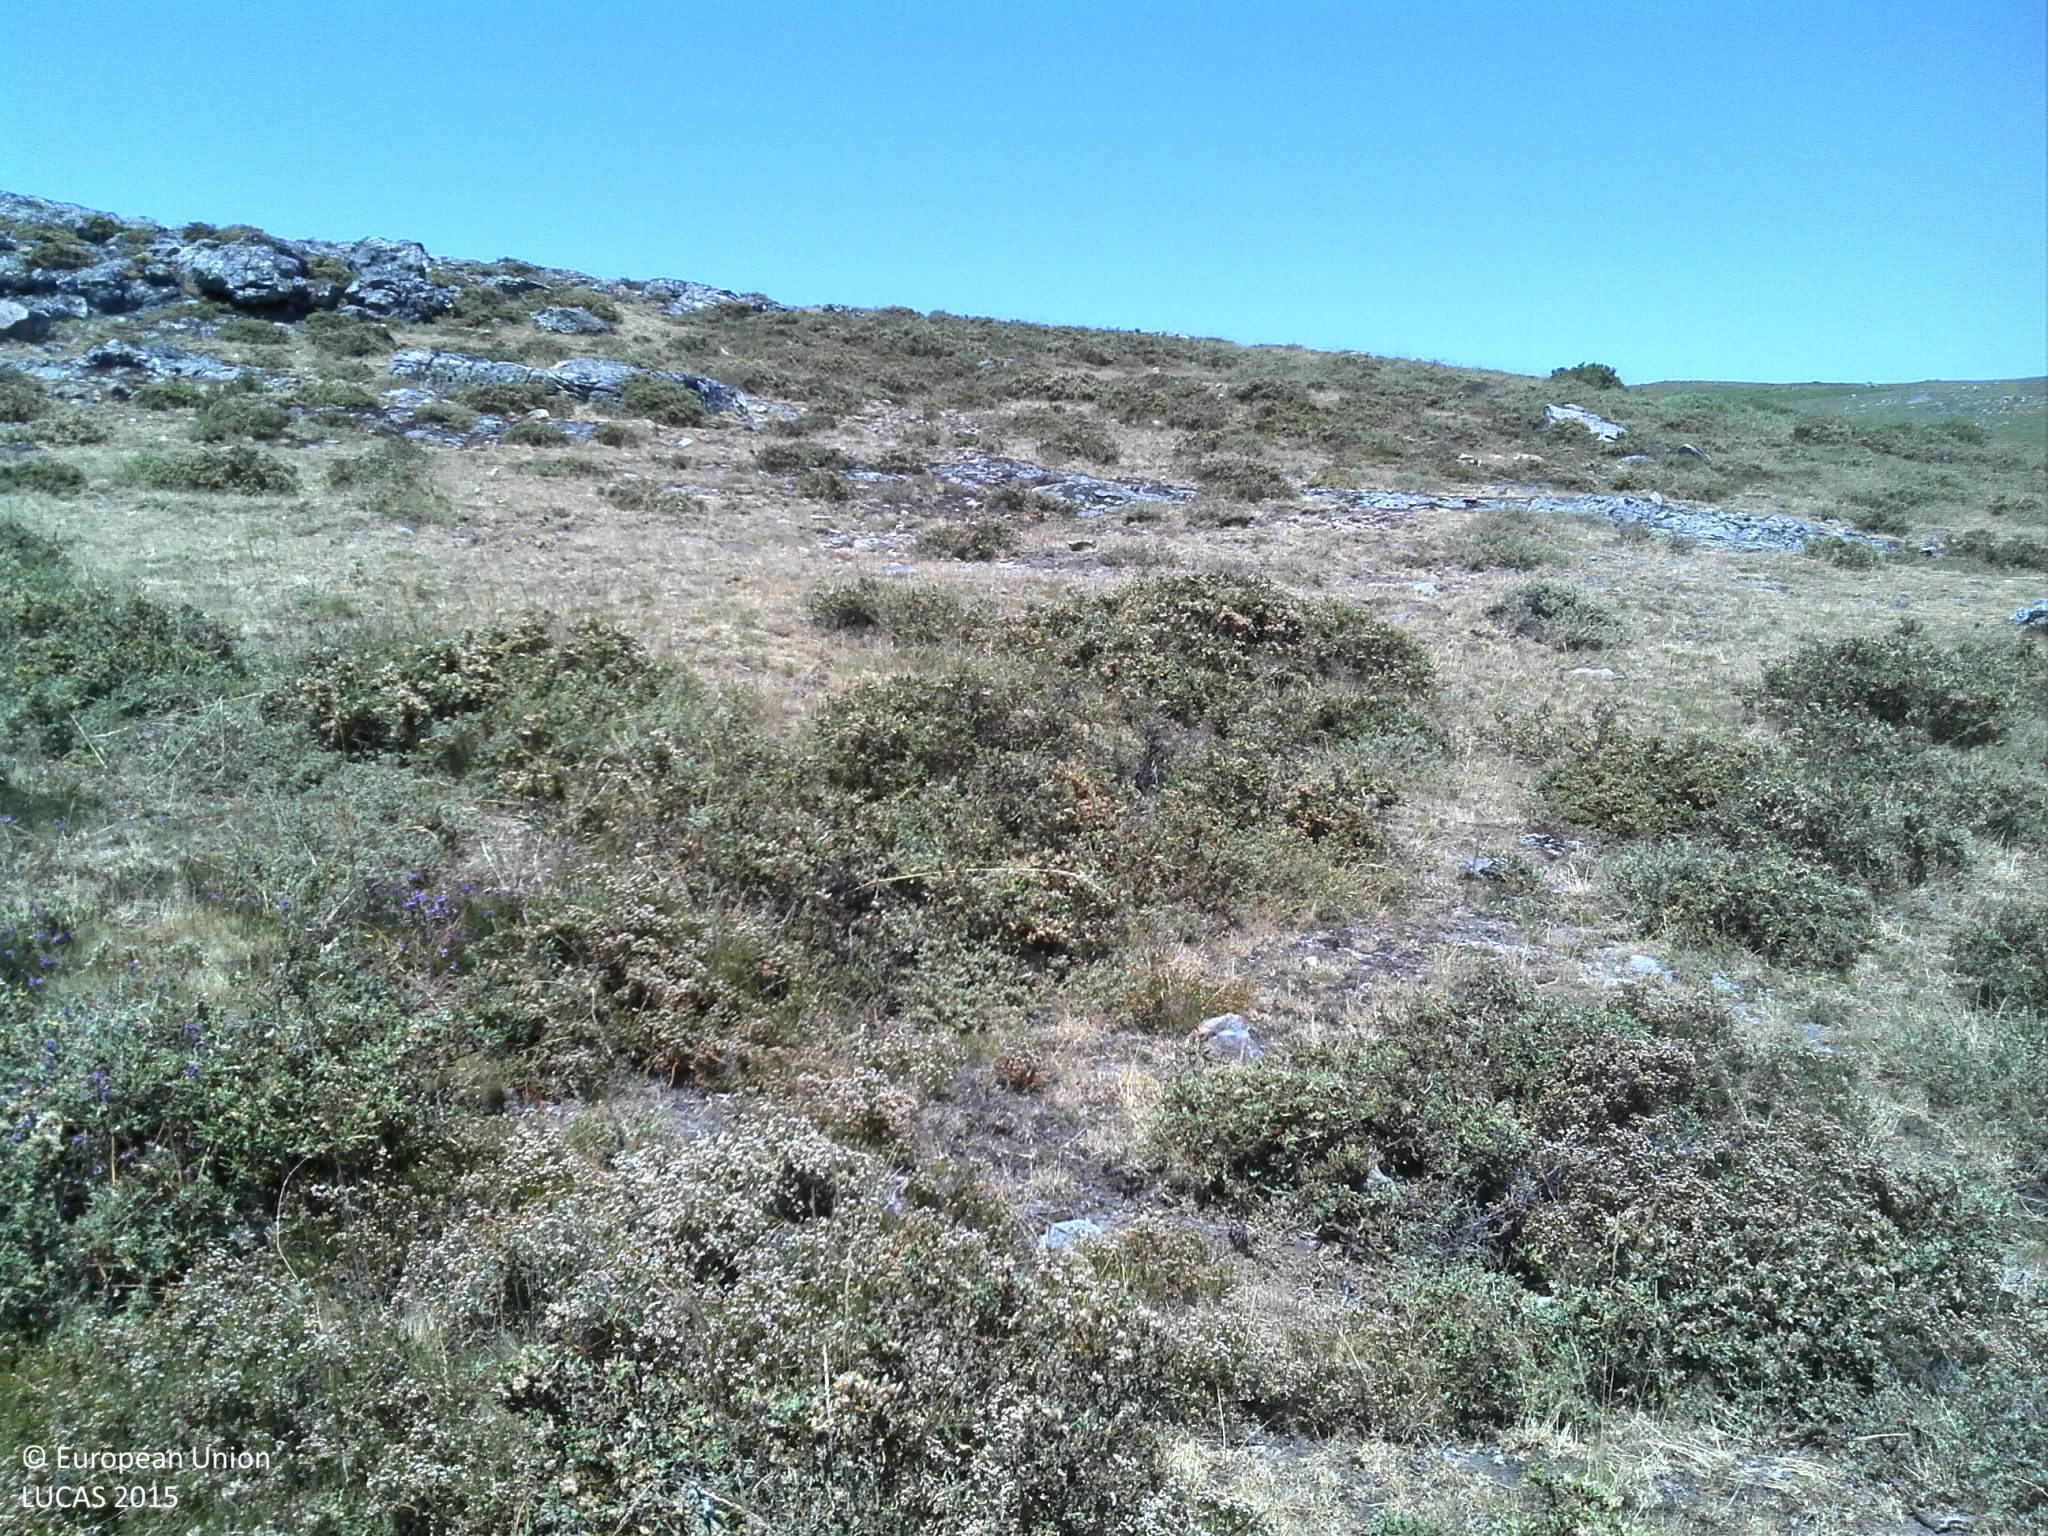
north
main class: Shrubland
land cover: Shrubland without tree cover
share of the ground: 50 - 75 %
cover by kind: shrubs 75 %, herbaceous plants 15 %, unconsolidated bare surface 10 %
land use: Agriculture (excluding fallow land and kitchen gardens)
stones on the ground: 25 - 50 %
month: July
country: PT
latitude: 41.8673
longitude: -7.9395
